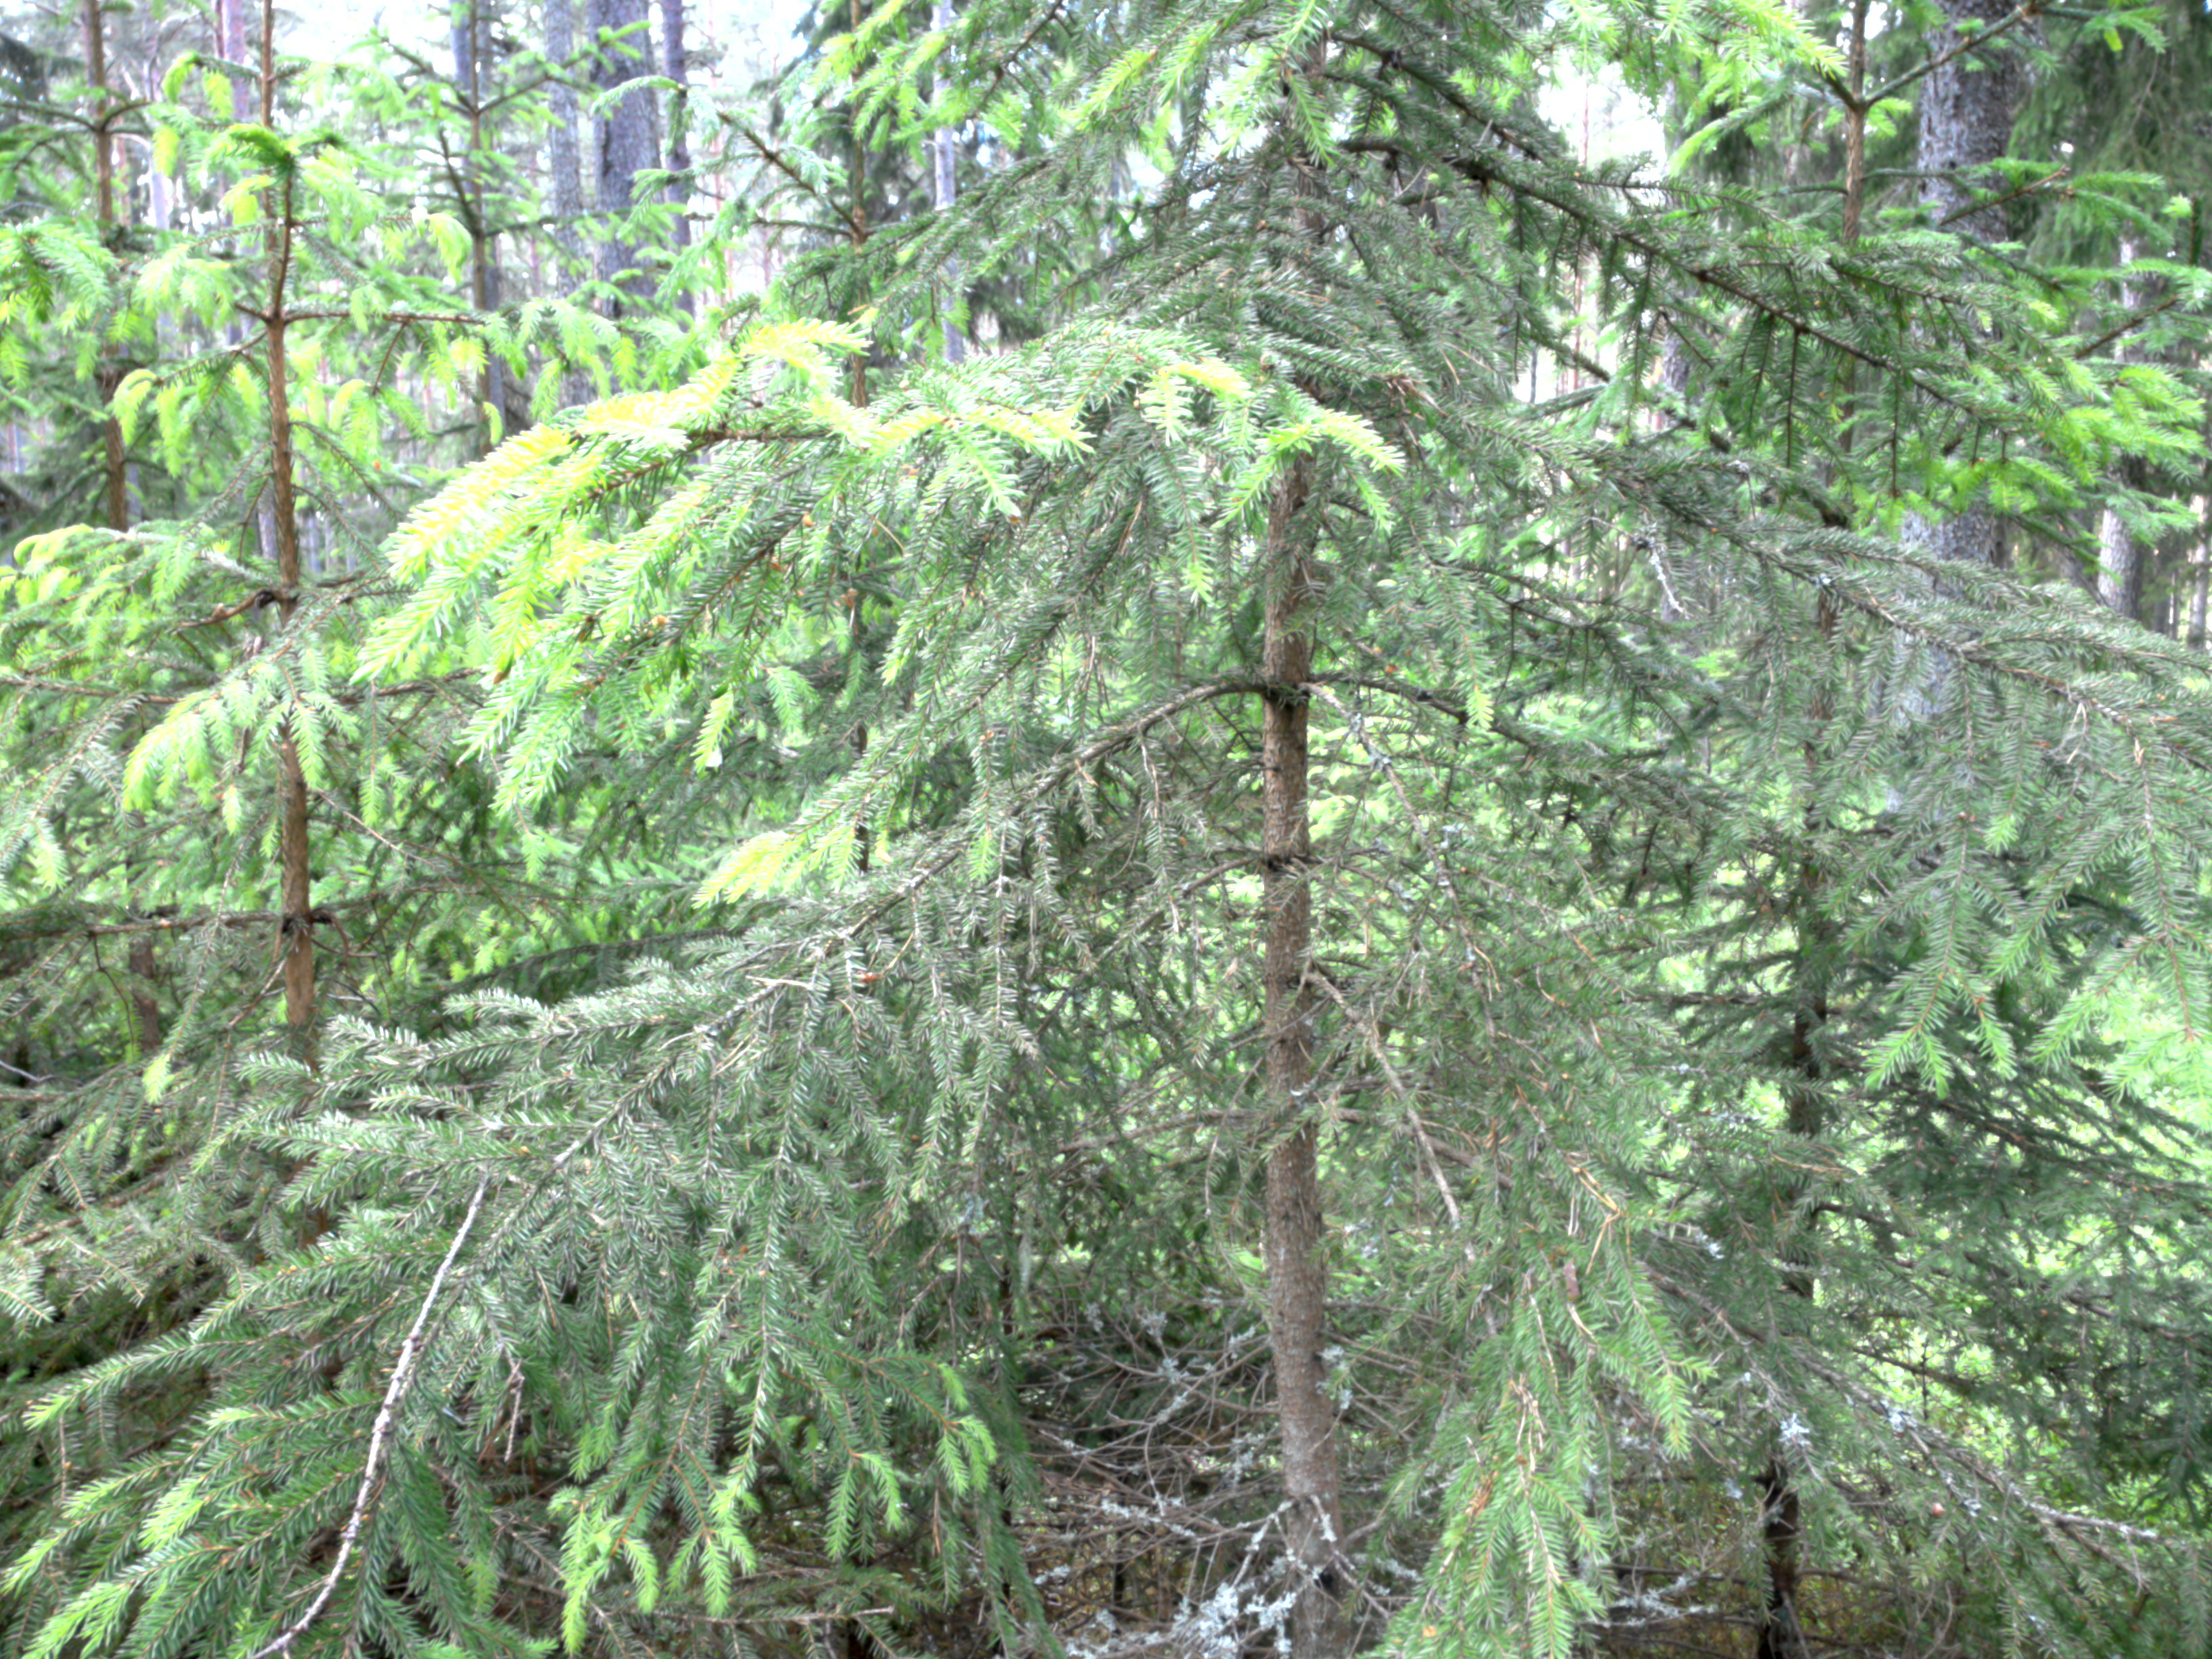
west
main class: Woodland
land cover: Pine dominated coniferous woodland
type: boreal forest
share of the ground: 50 - 75 %
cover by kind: coniferous forest trees 70 %, shrubs 20 %, lichens and mosses 10 %
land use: Forestry
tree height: > 5 m
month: June
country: SE
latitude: 59.2187
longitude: 17.5474
